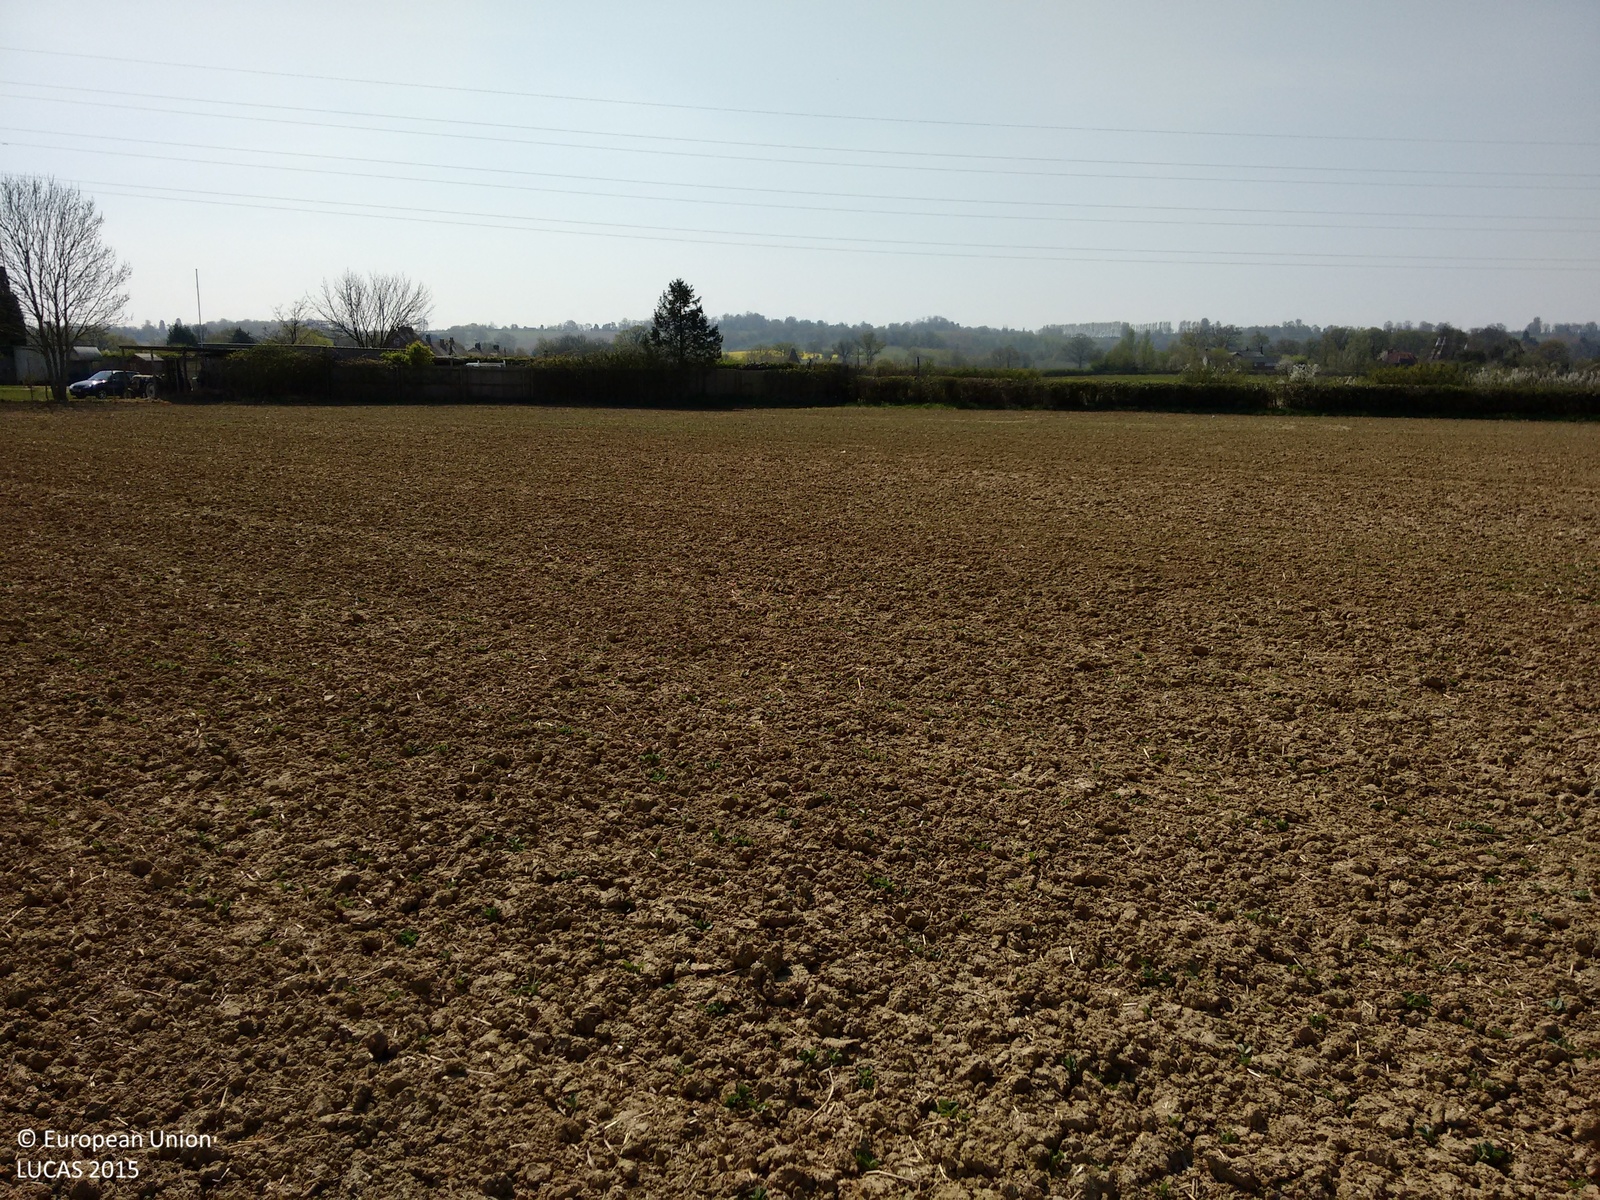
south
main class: Cropland
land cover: Dry pulses
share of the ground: < 10 %
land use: Agriculture (excluding fallow land and kitchen gardens)
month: April
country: GB
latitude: 51.1729
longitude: 0.4024
